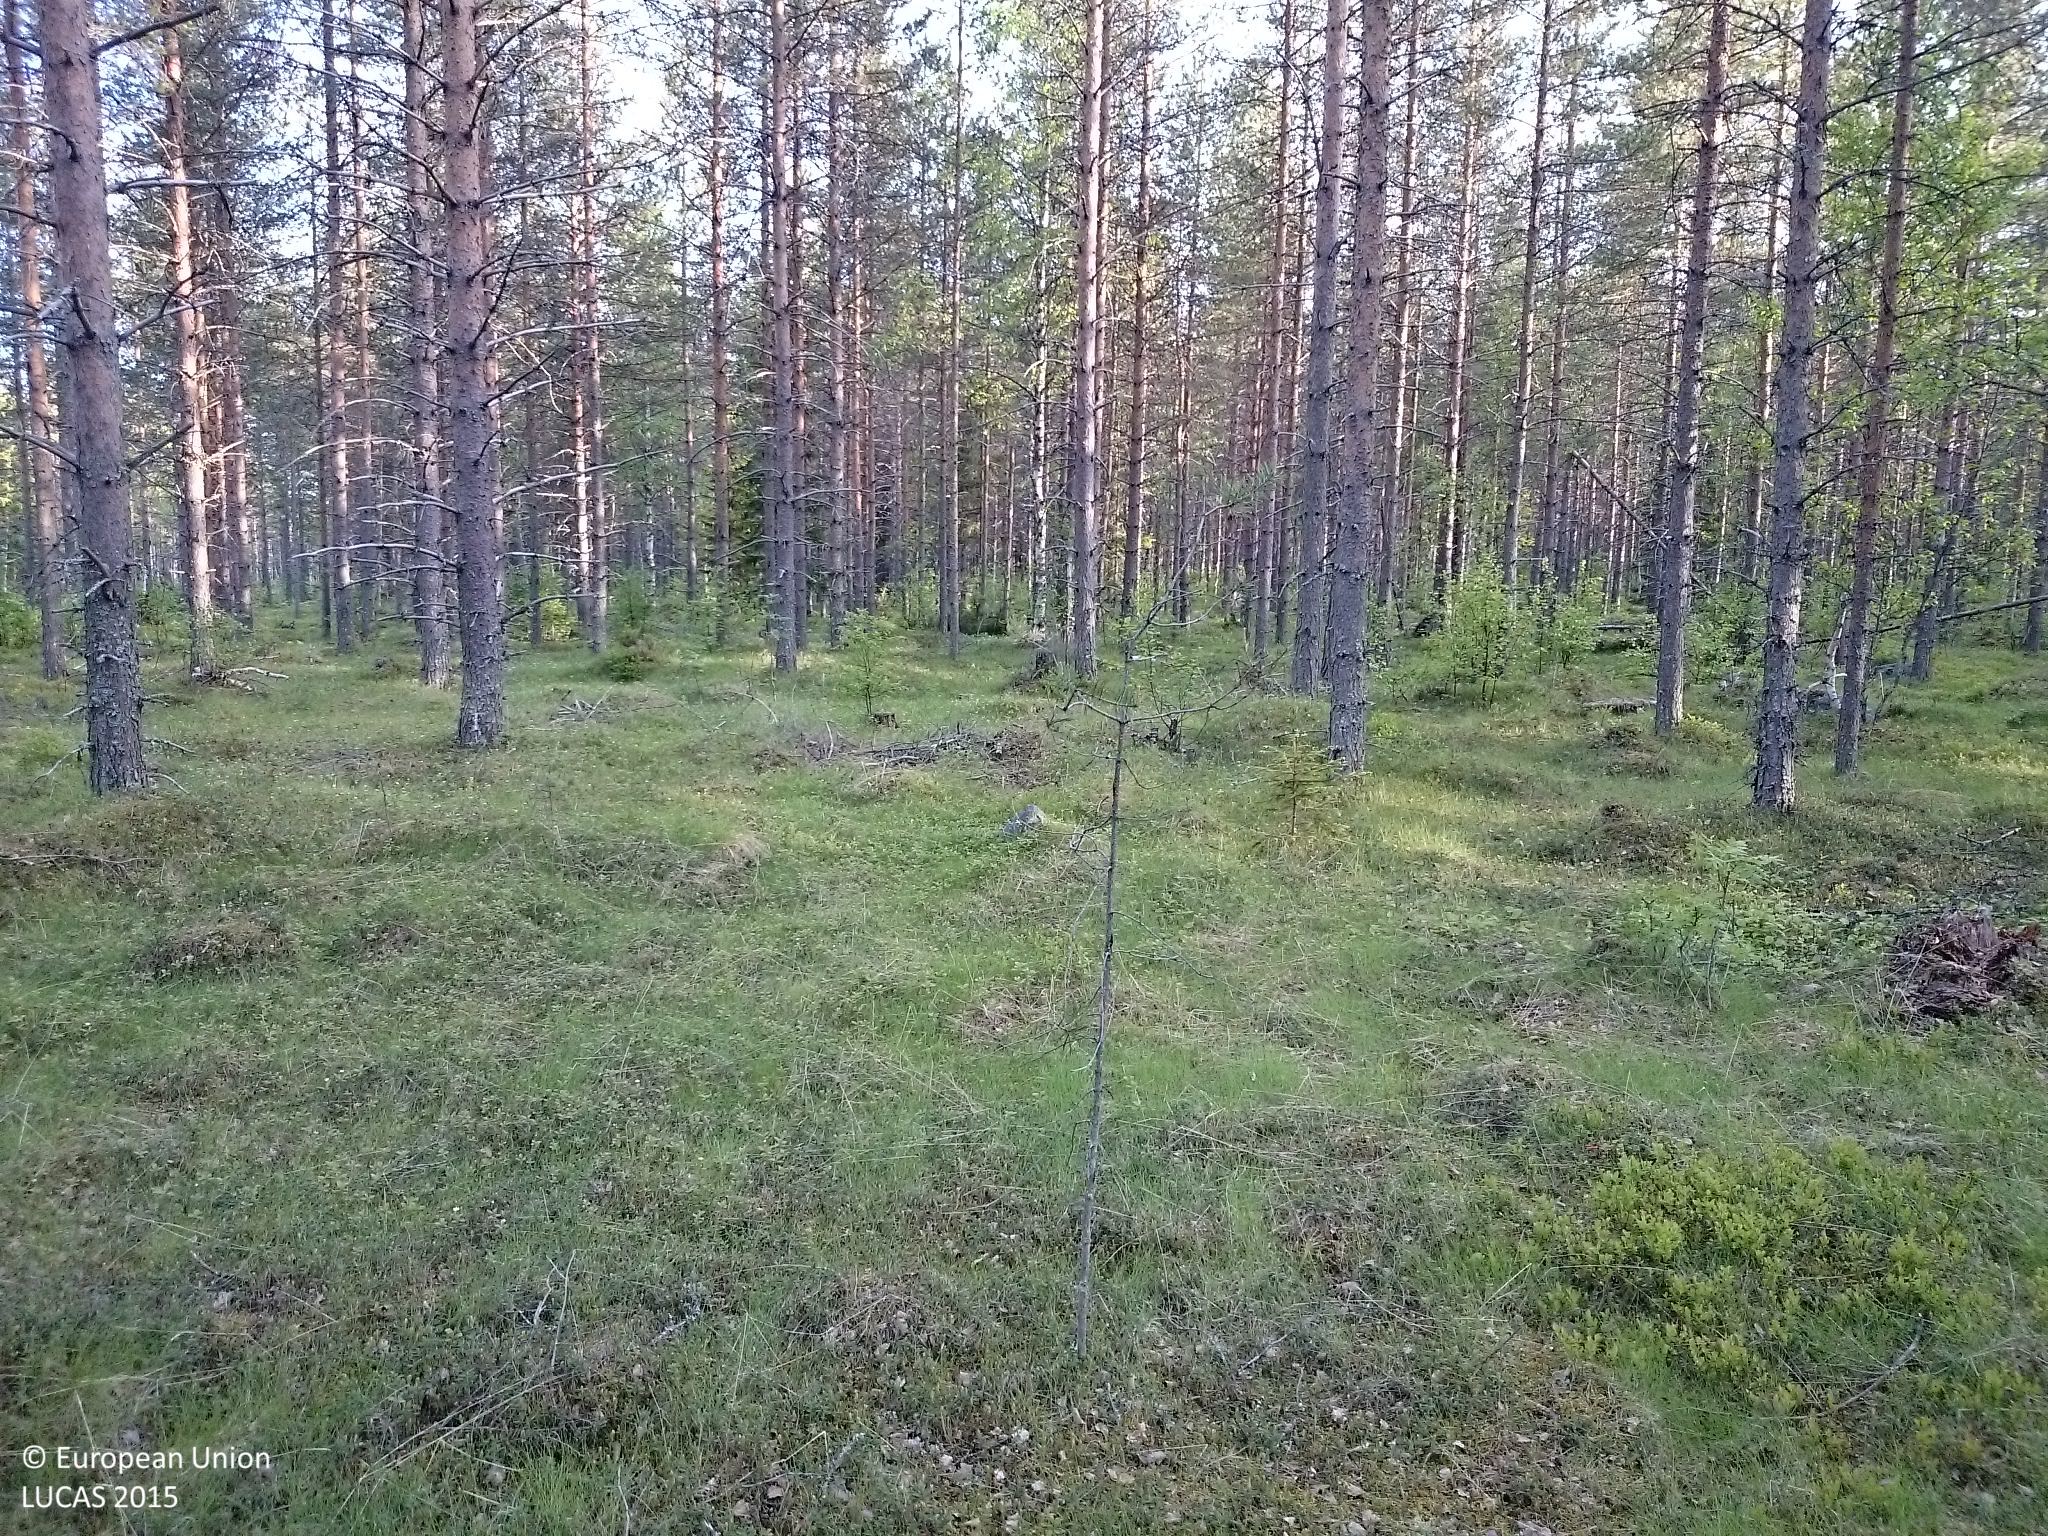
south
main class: Woodland
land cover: Pine dominated mixed woodland
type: boreal forest
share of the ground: 50 - 75 %
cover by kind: coniferous forest trees 45 %, shrubs 25 %, broadleaved forest trees 15 %, herbaceous plants 15 %
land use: Forestry
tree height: > 5 m
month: June
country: SE
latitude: 64.0446
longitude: 20.5693
